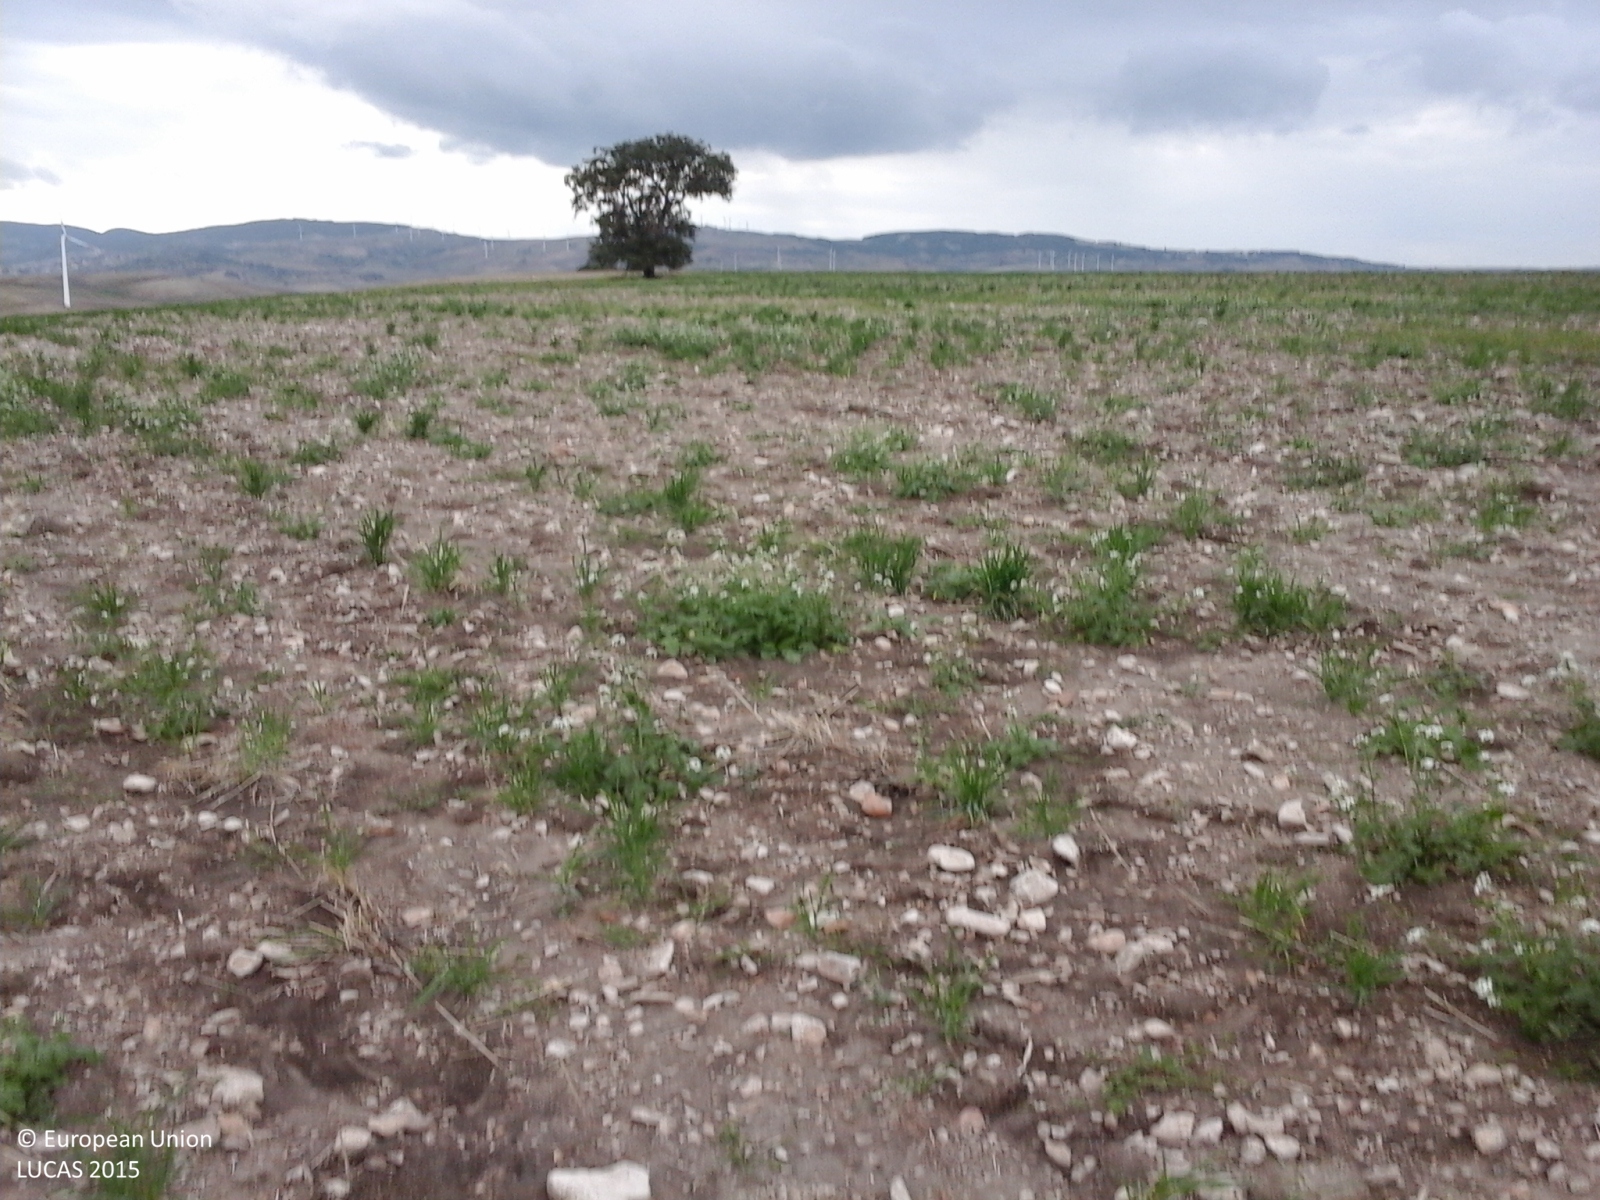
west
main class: Cropland
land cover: Durum wheat
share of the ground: > 75 %
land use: Agriculture (excluding fallow land and kitchen gardens)
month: October
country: IT
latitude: 41.5611
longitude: 15.1988
